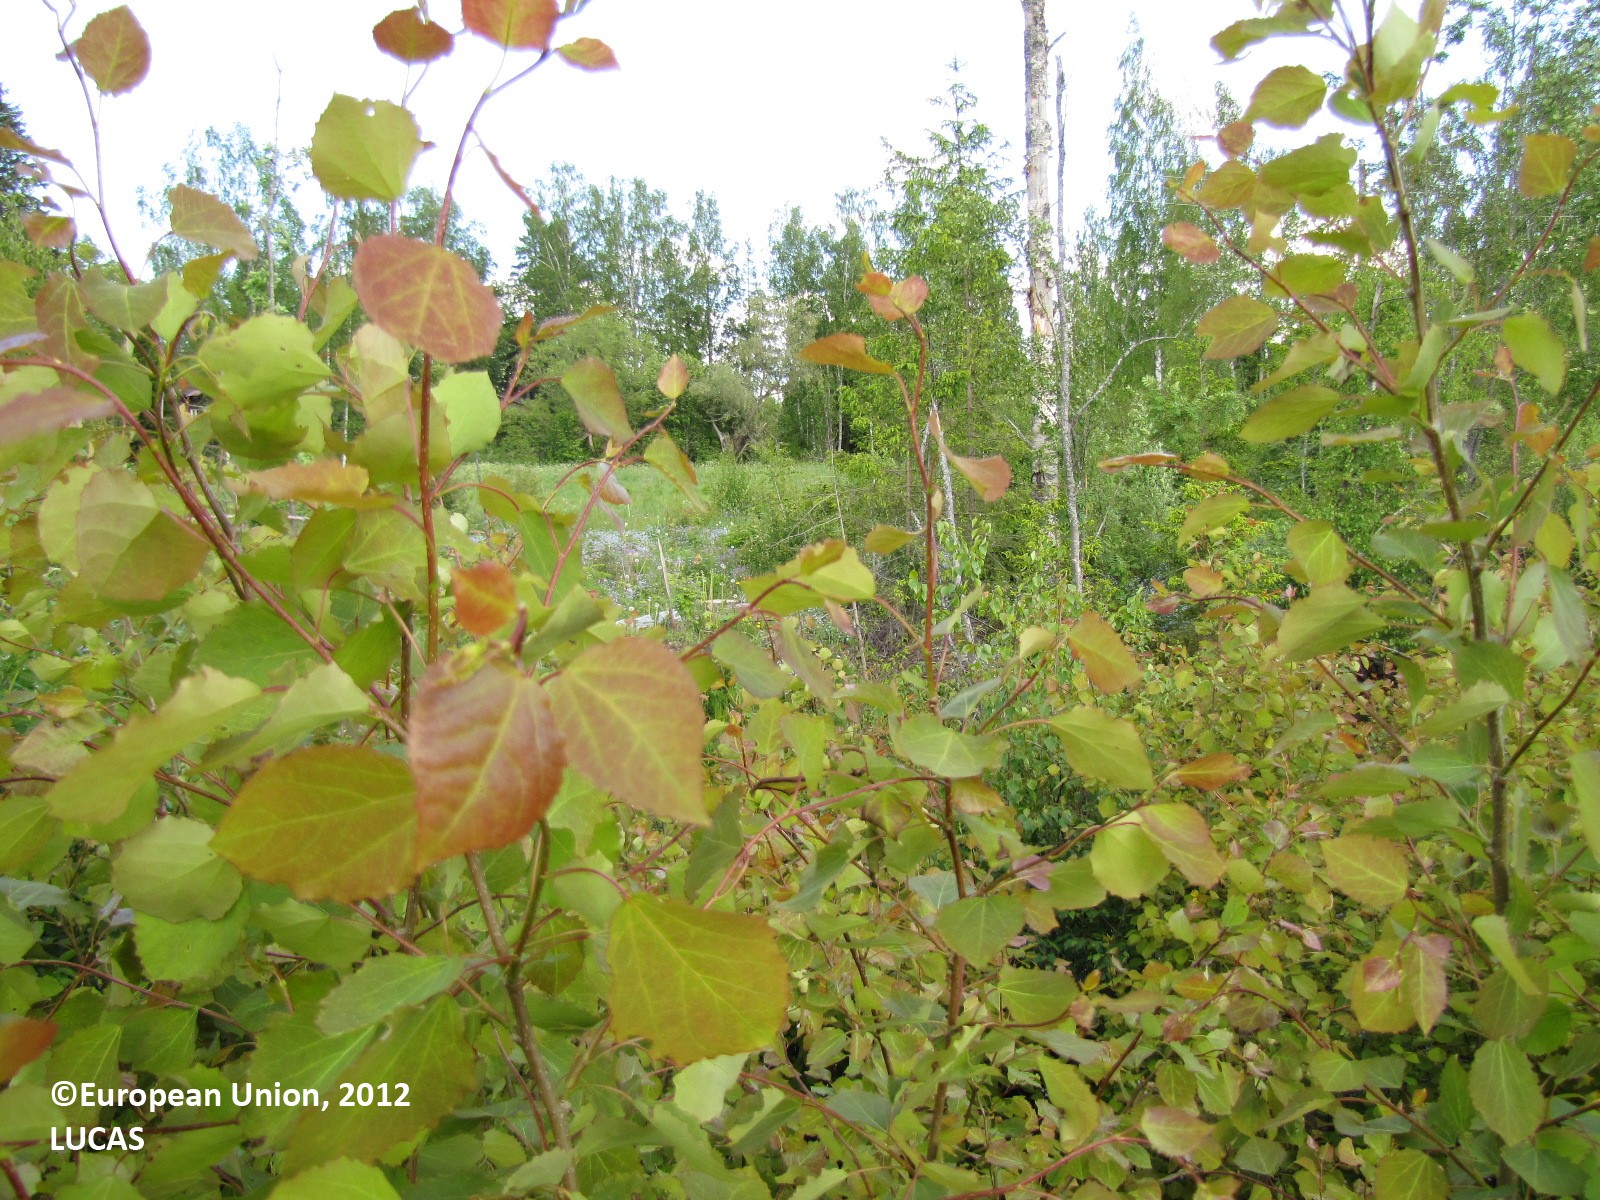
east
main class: Woodland
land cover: Broadleaved woodland
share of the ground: 25 - 50 %
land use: Semi-natural and natural areas not in use
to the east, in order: Broadleaved woodland; Rivers and streams; Grassland with sparse tree/shrub cover; Electric lines; Ditches and canals; Spontaneously vegetated surfaces; Ditches and canals; Abandoned hedges; Tracks; Grass margins; Broadleaved woodland; Artificial constructions in urban areas; Other mixed woodland; Spruce dominated mixed woodland; Broadleaved woodland
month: June
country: FI
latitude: 61.4213
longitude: 23.0209
